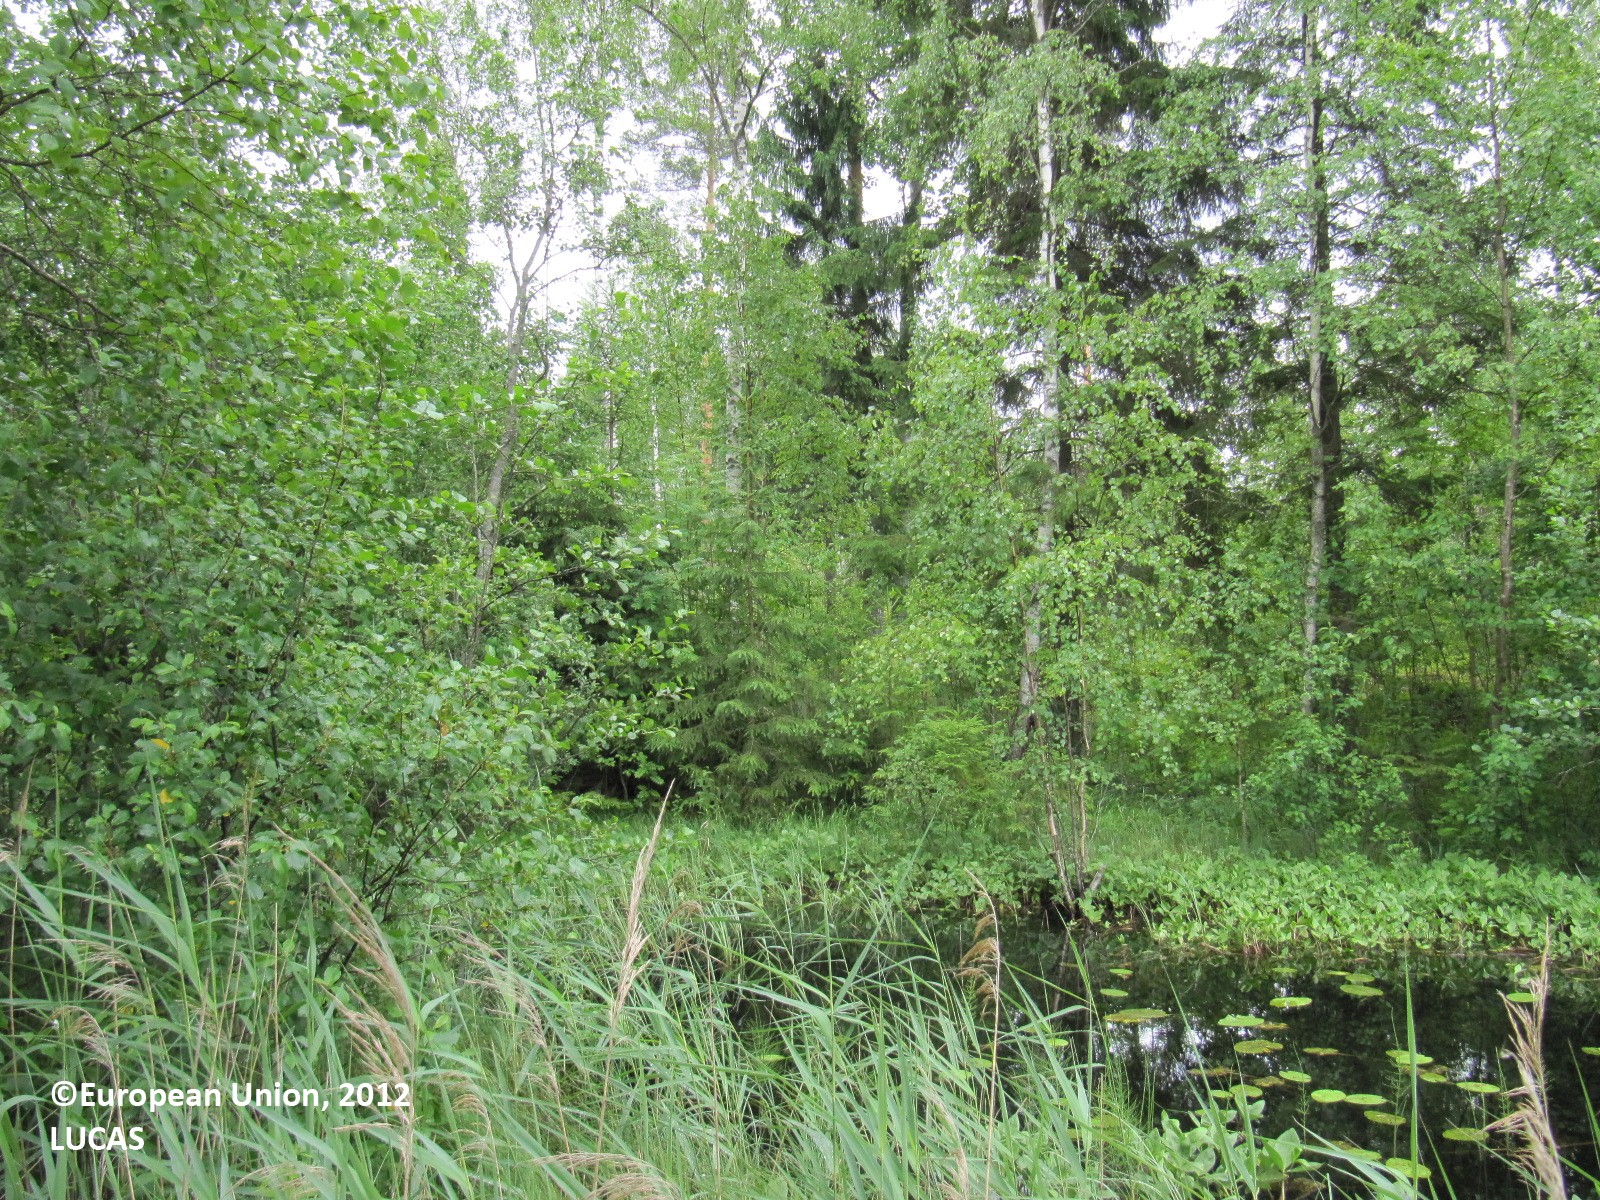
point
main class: Woodland
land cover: Other mixed woodland
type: boreal forest
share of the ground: > 75 %
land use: Forestry
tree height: > 5 m
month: July
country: FI
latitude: 60.9273
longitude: 24.1727
